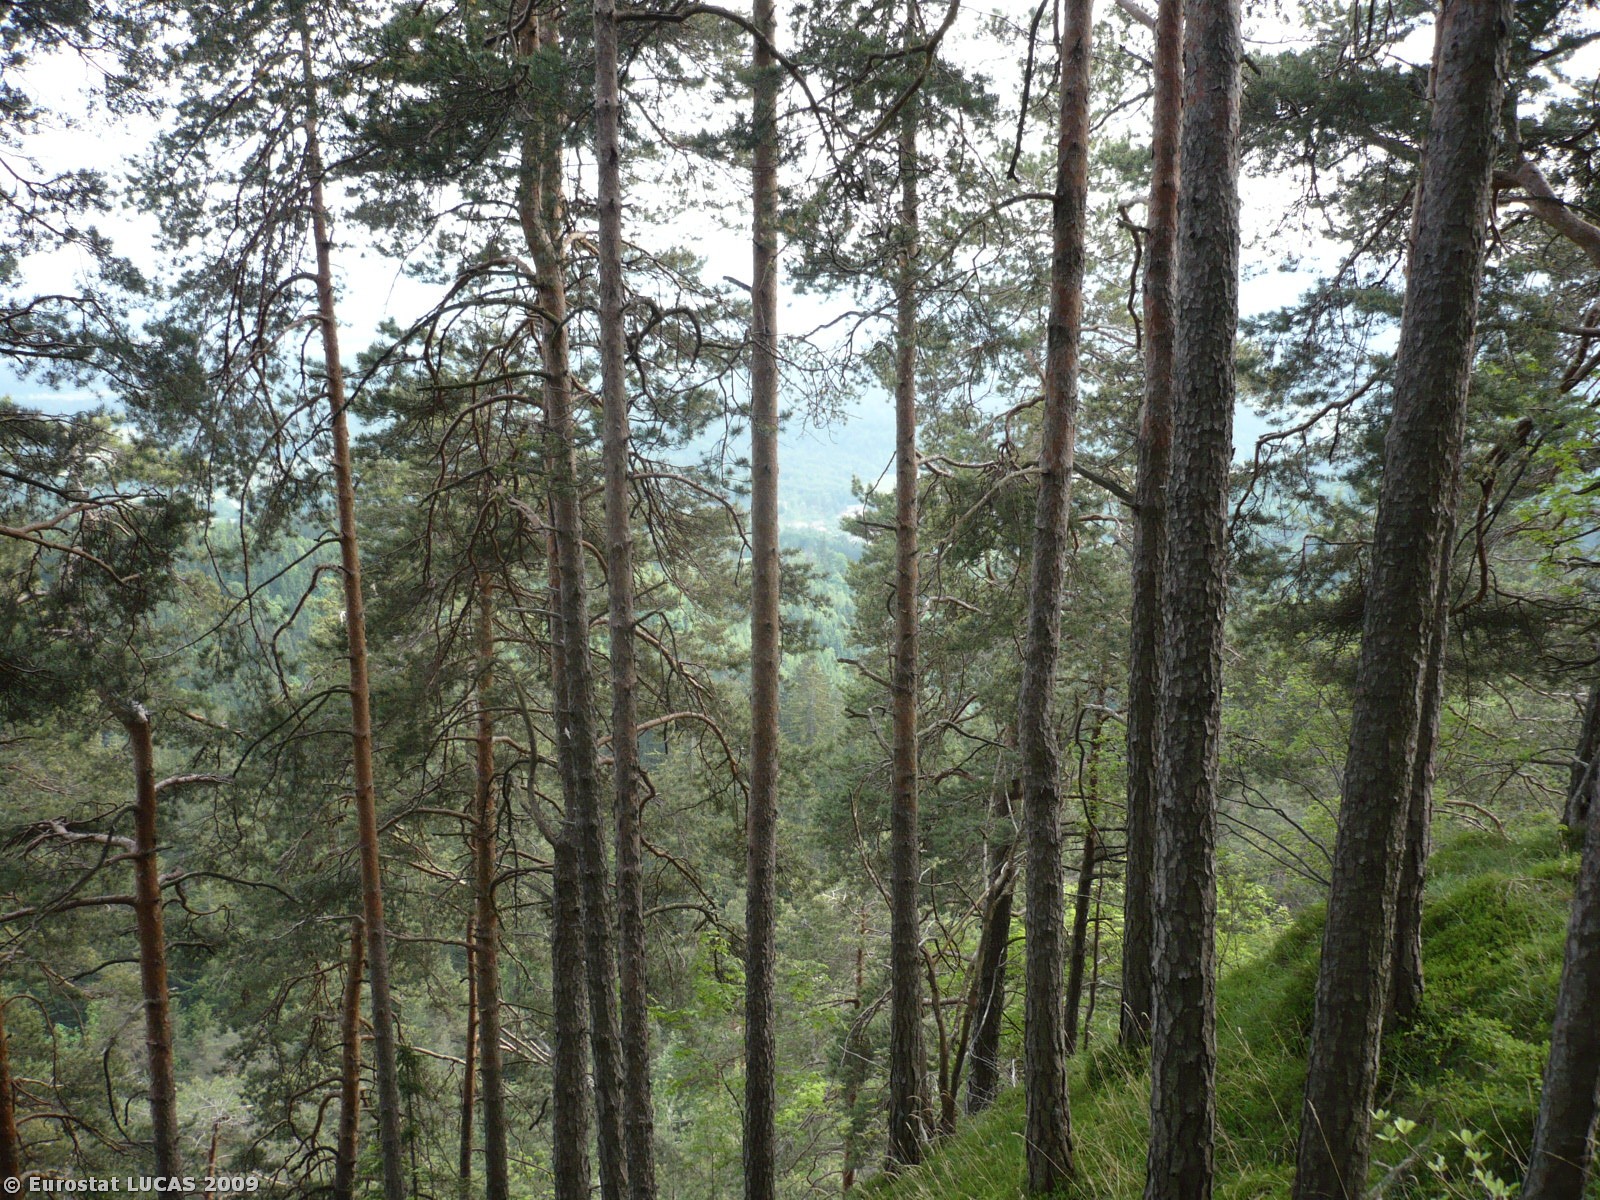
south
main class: Woodland
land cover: Coniferous woodland
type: alpine coniferous forest
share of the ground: 50 - 75 %
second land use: Nature reserves
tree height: > 5 m
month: May
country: SI
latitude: 46.3339
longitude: 14.3749
